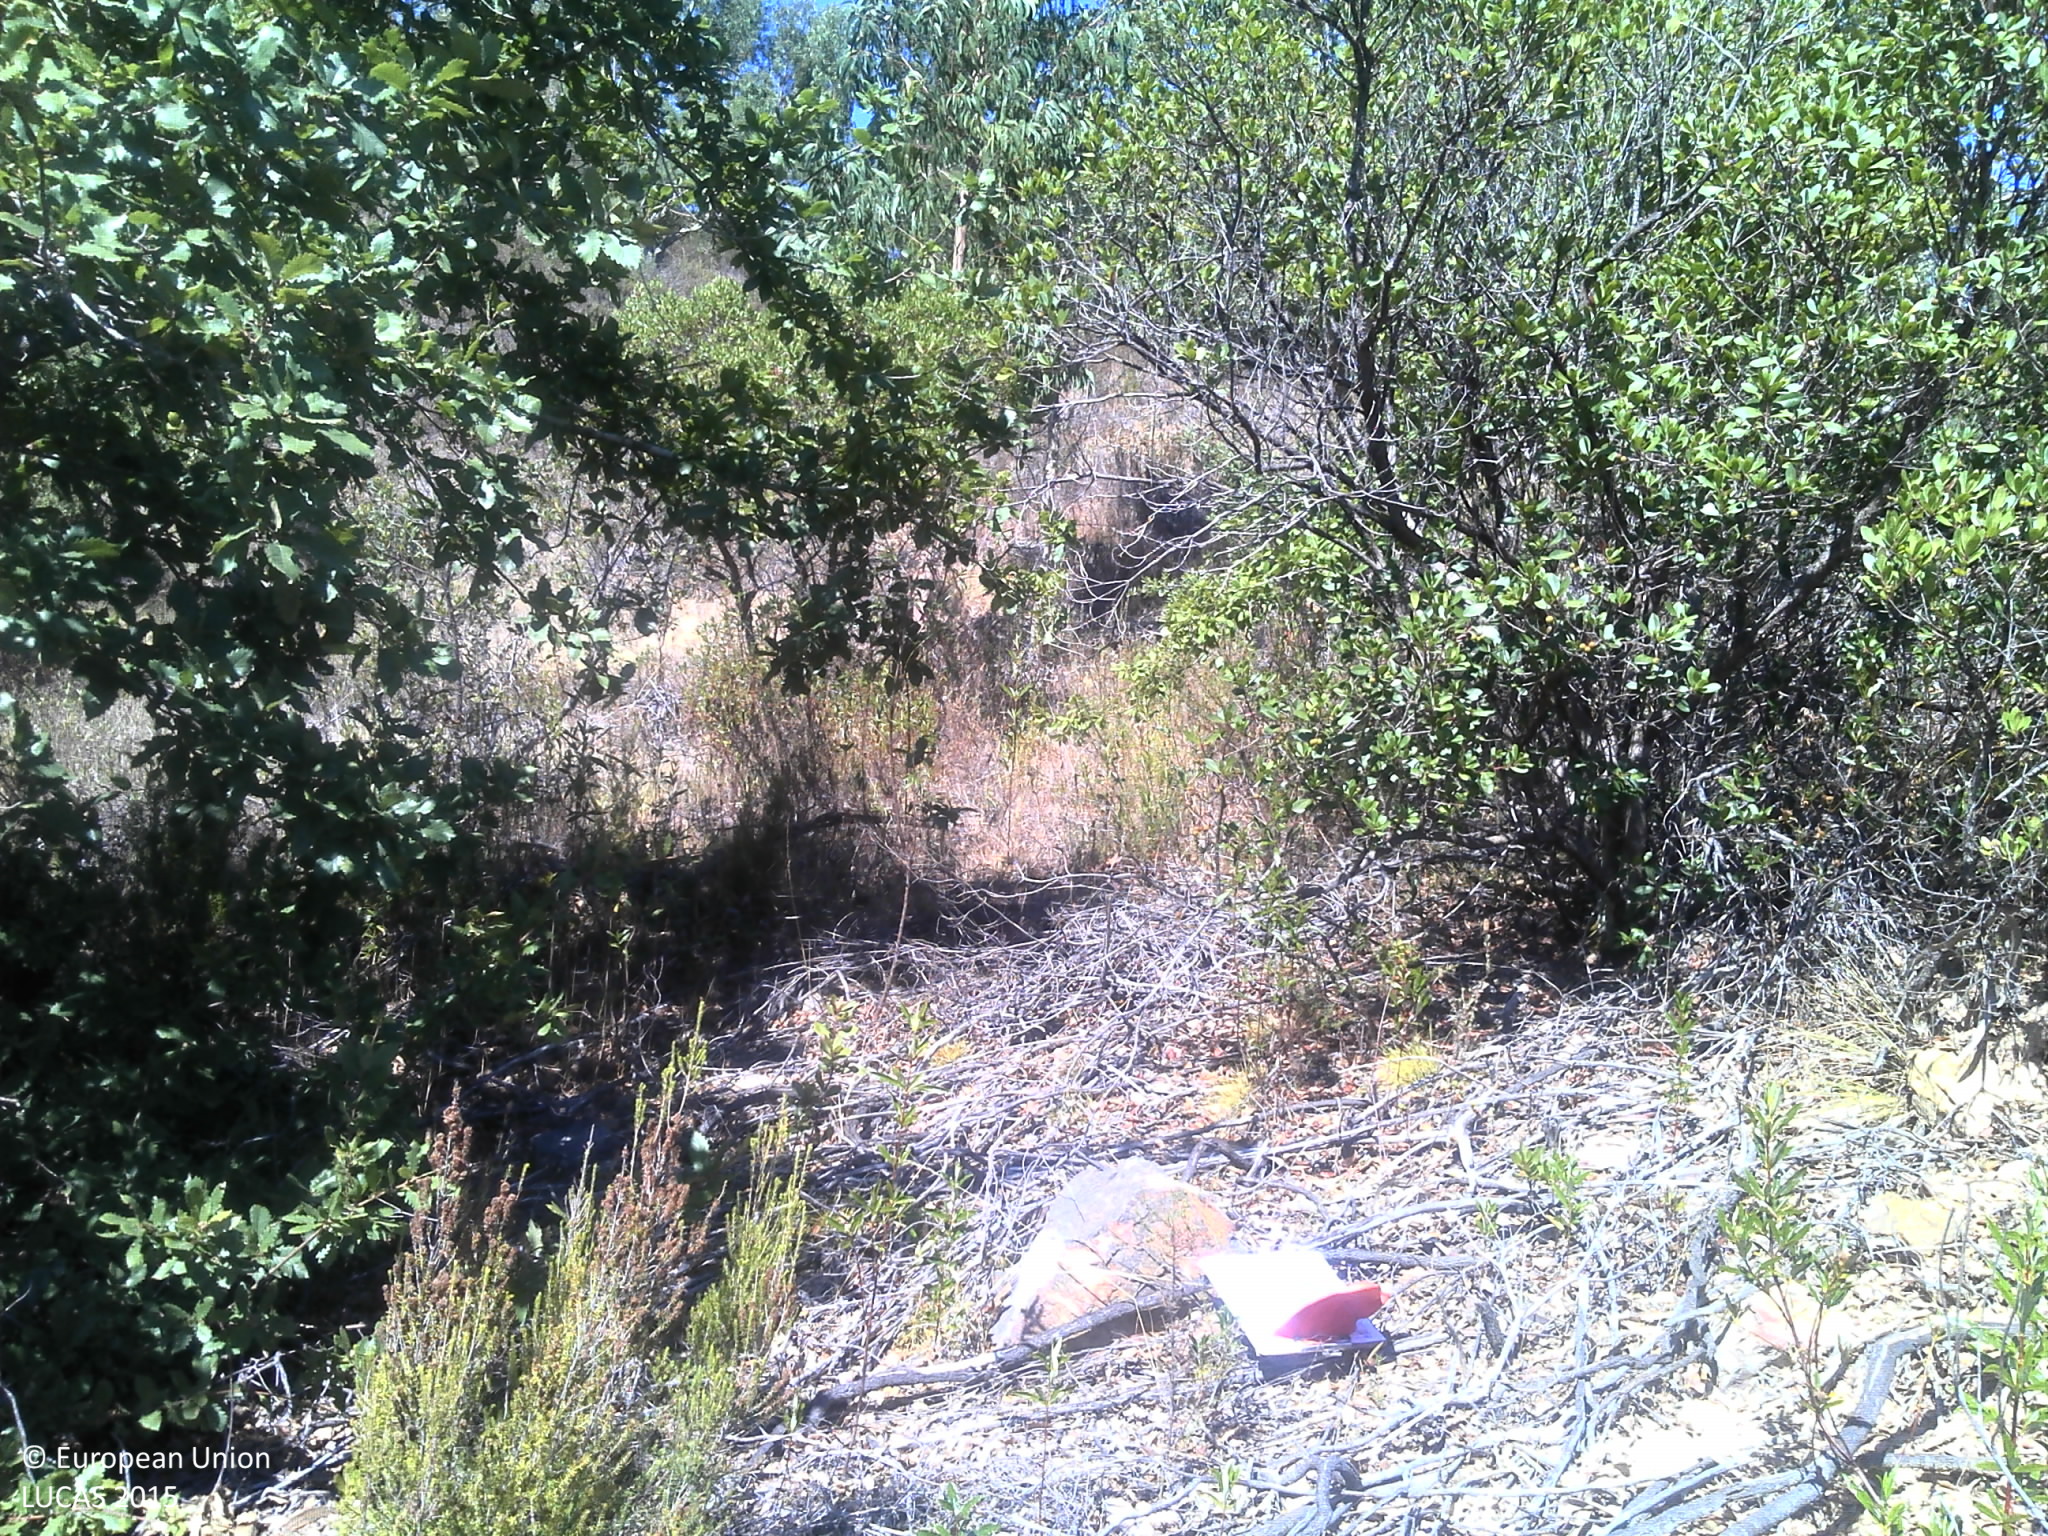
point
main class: Woodland
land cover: Broadleaved woodland
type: broadleaved evergreen forest
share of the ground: 25 - 50 %
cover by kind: broadleaved forest trees 40 %, shrubs 20 %, herbaceous plants 20 %, unconsolidated bare surface 20 %
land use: Forestry
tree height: > 5 m
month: August
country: PT
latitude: 37.4070
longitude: -8.7337
